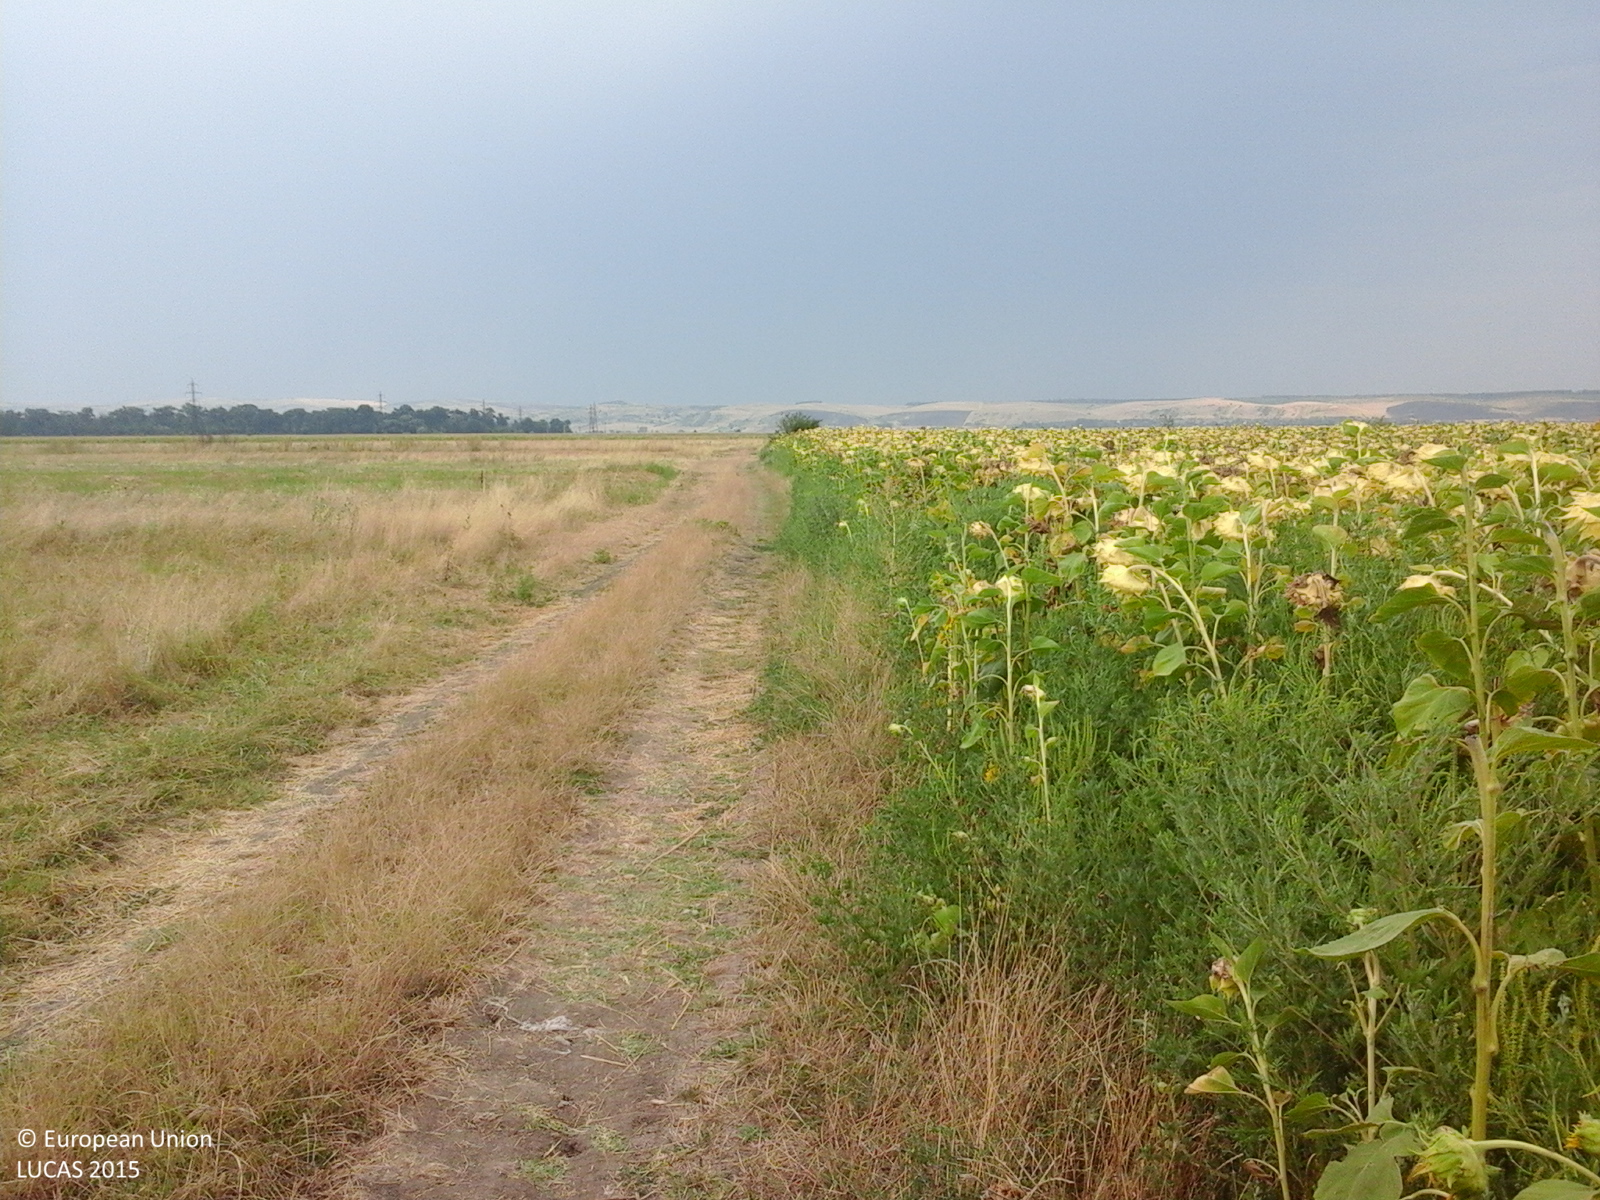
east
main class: Cropland
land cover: Sunflower
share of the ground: > 75 %
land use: Agriculture (excluding fallow land and kitchen gardens)
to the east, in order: Sunflower; Common wheat; Grassland without tree/shrub cover; Ditches and canals; Grass margins; Tracks; Grass margins; Sunflower
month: August
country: RO
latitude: 44.4099
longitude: 22.8132
